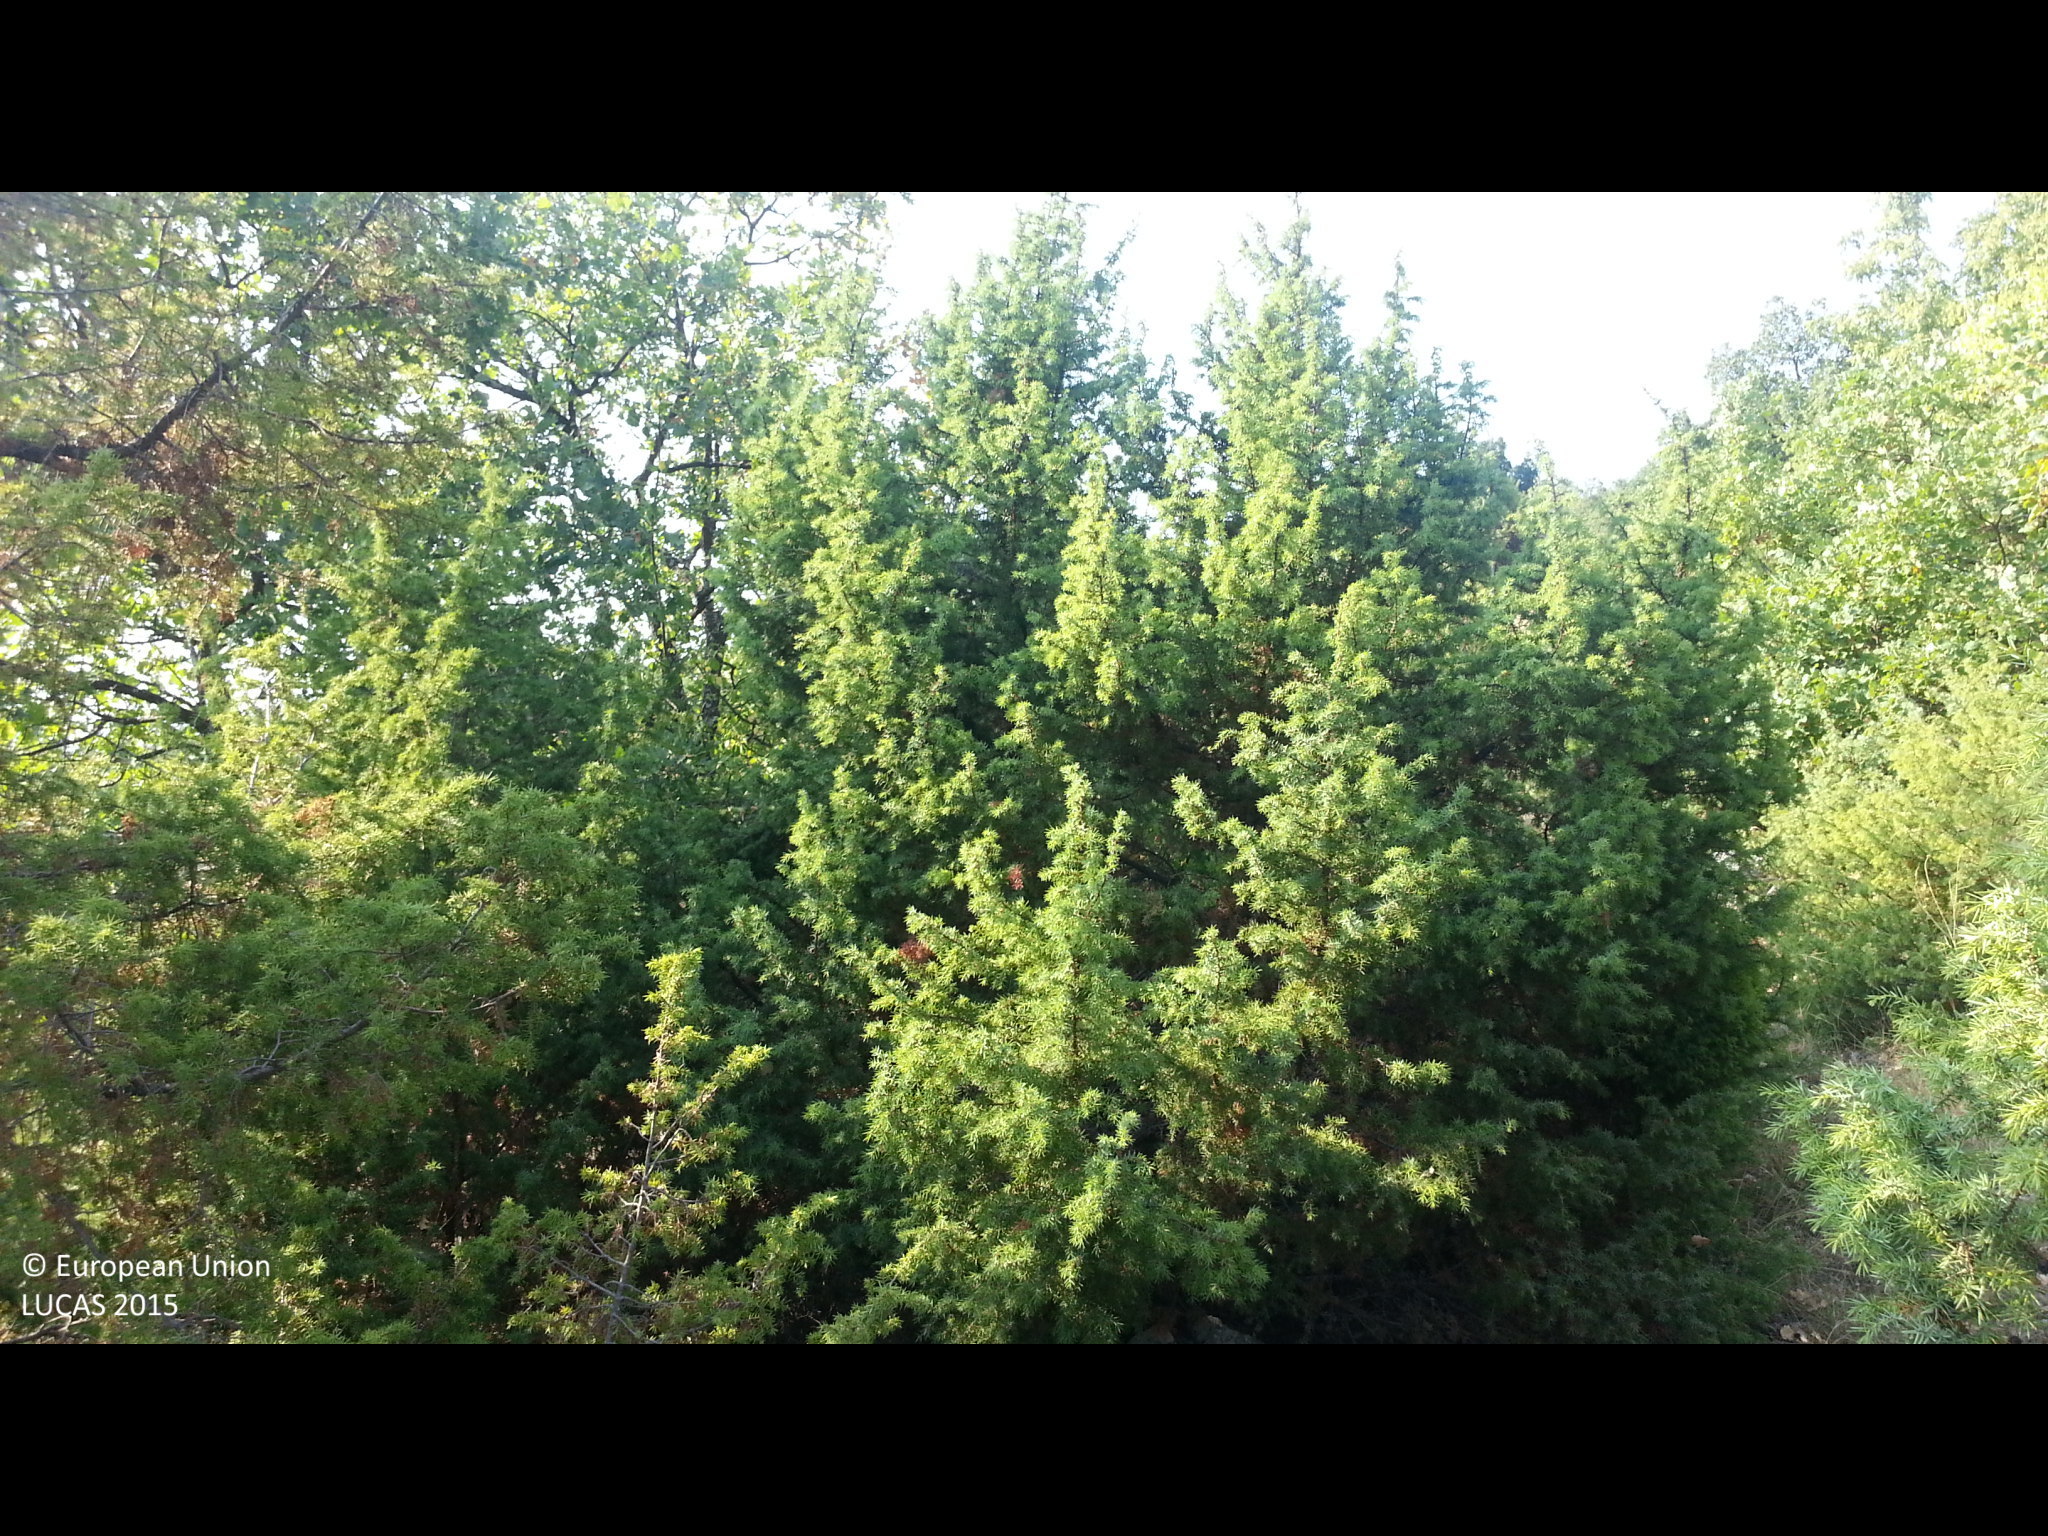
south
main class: Shrubland
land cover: Shrubland with sparse tree cover
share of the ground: > 75 %
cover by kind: shrubs 75 %, herbaceous plants 20 %, broadleaved forest trees 5 %
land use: Semi-natural and natural areas not in use
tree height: < 5 m
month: August
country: BG
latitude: 42.4233
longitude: 22.6502
